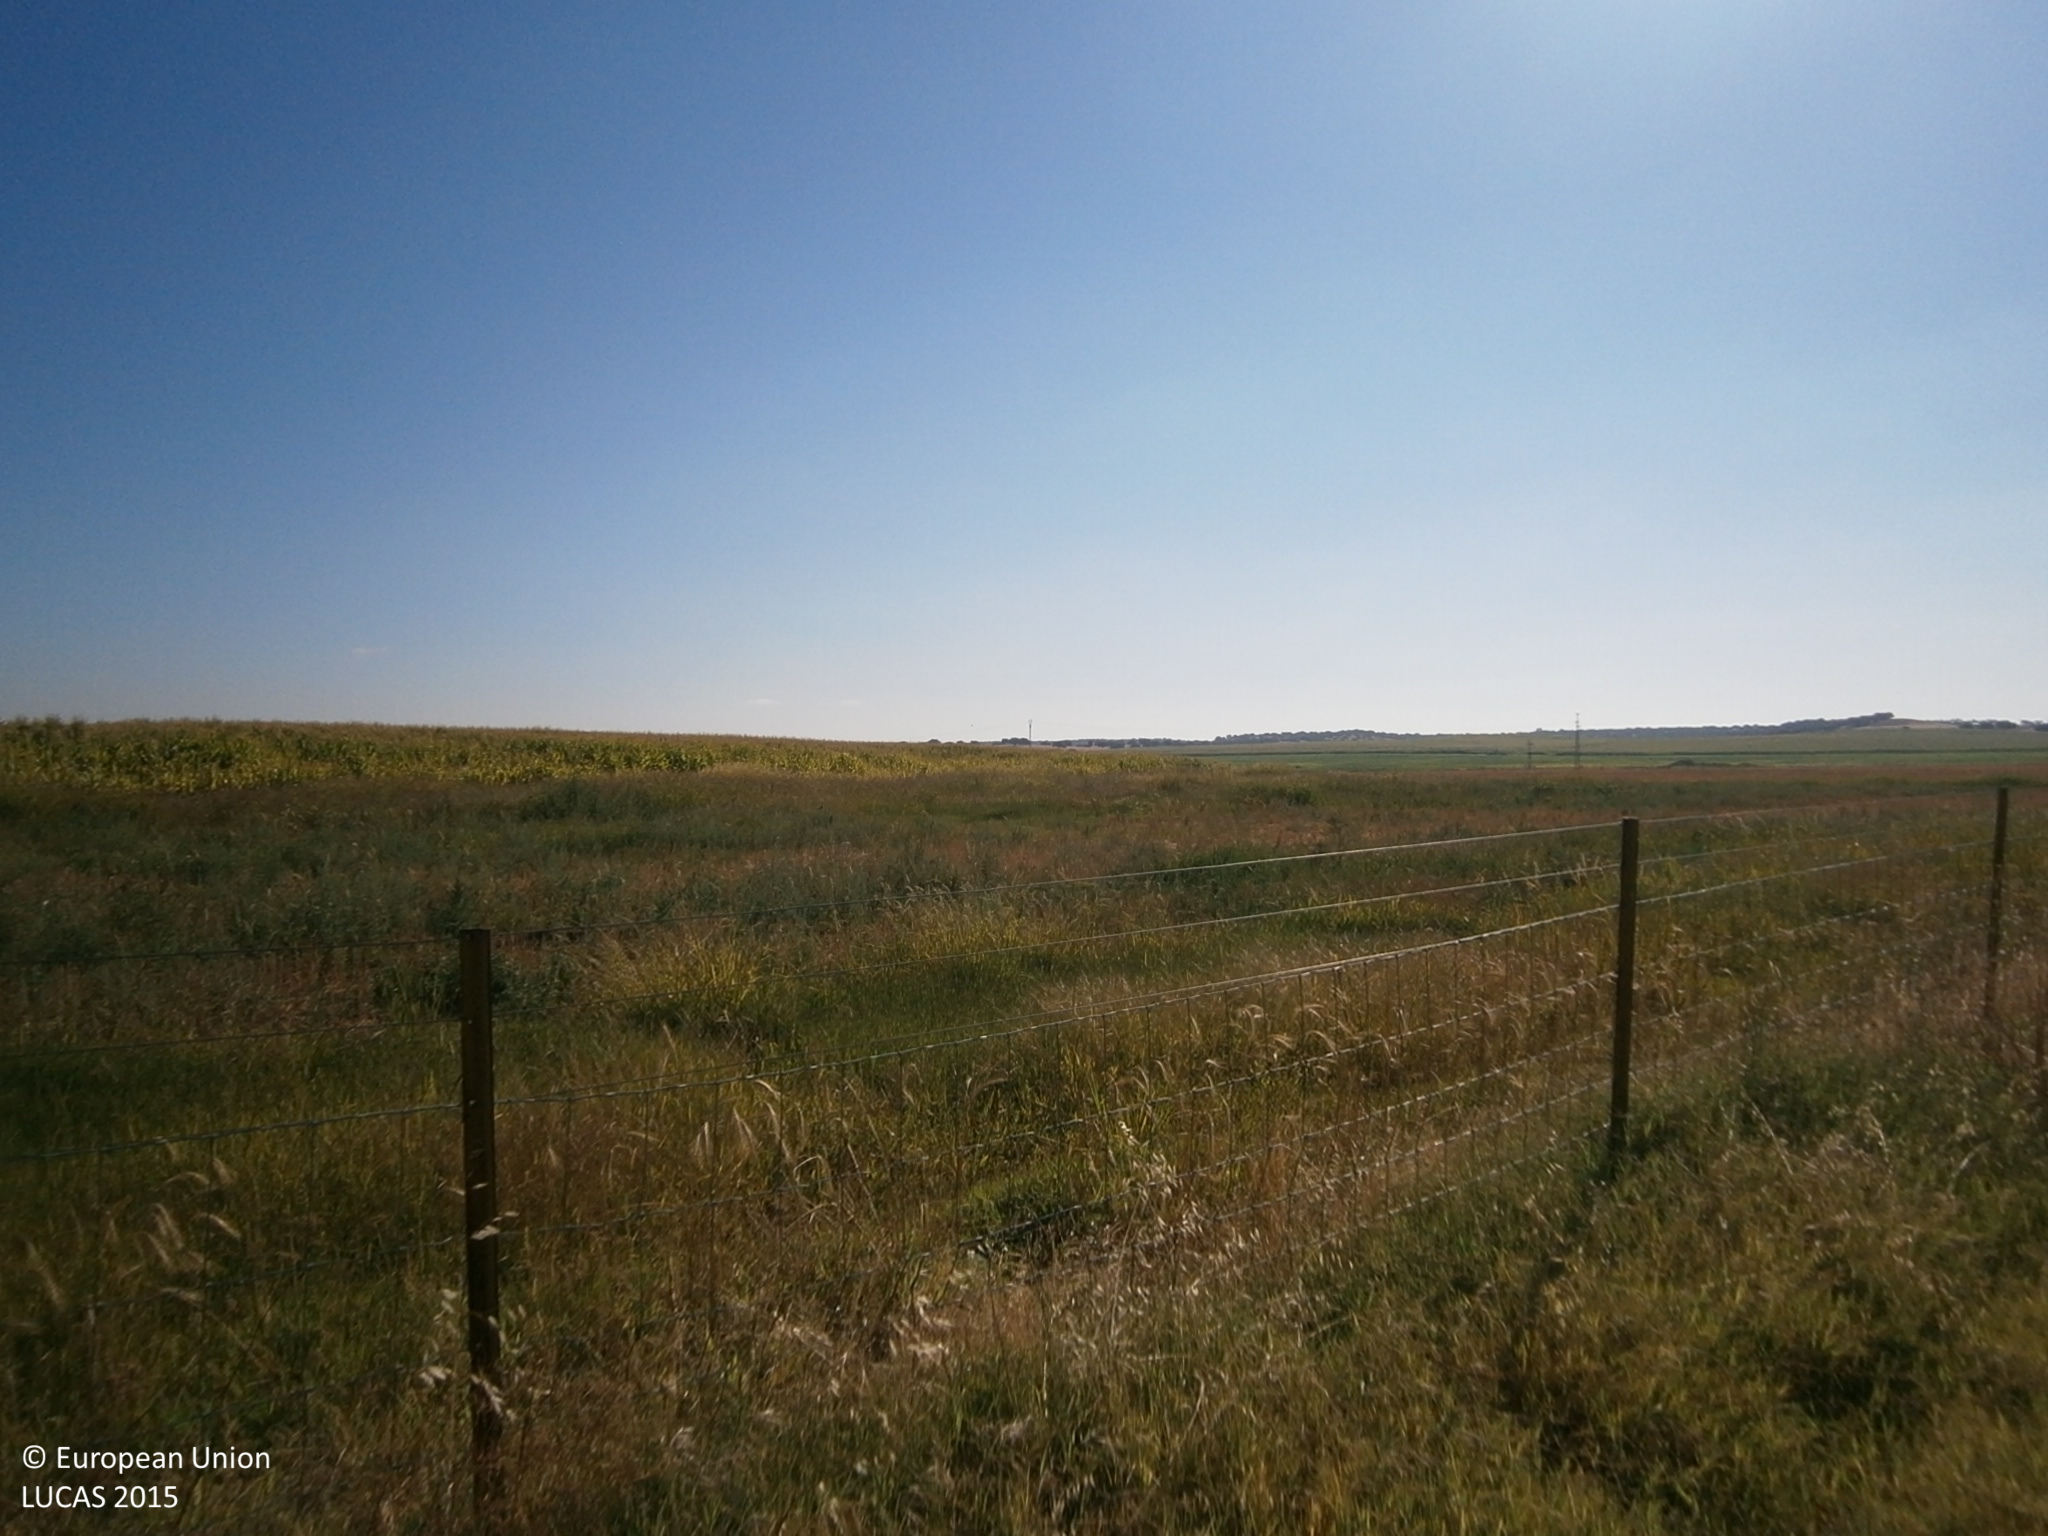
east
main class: Cropland
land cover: Maize
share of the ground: > 75 %
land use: Agriculture (excluding fallow land and kitchen gardens)
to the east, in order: Maize; Spontaneously vegetated surfaces
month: July
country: ES
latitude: 38.7311
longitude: -7.2240
